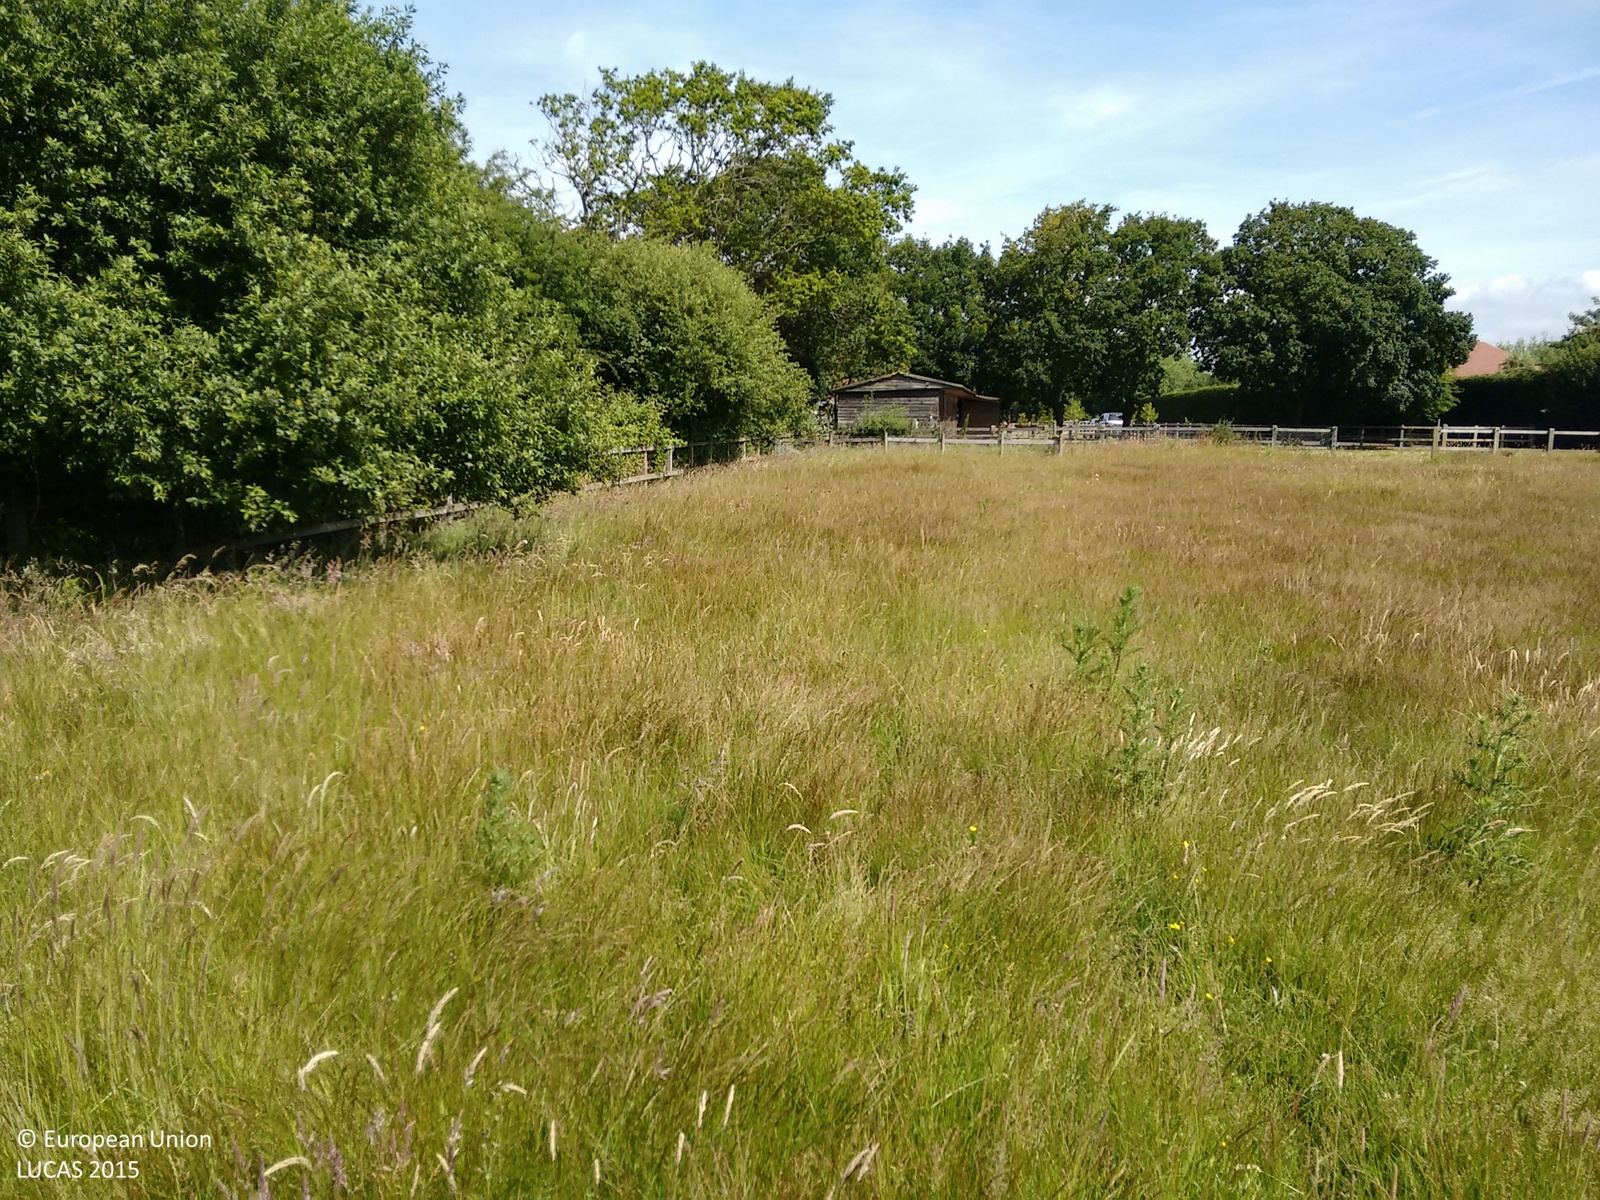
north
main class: Grassland
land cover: Grassland without tree/shrub cover
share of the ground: > 75 %
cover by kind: herbaceous plants 100 %
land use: Agriculture (excluding fallow land and kitchen gardens)
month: June
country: GB
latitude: 50.7884
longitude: -0.8658
